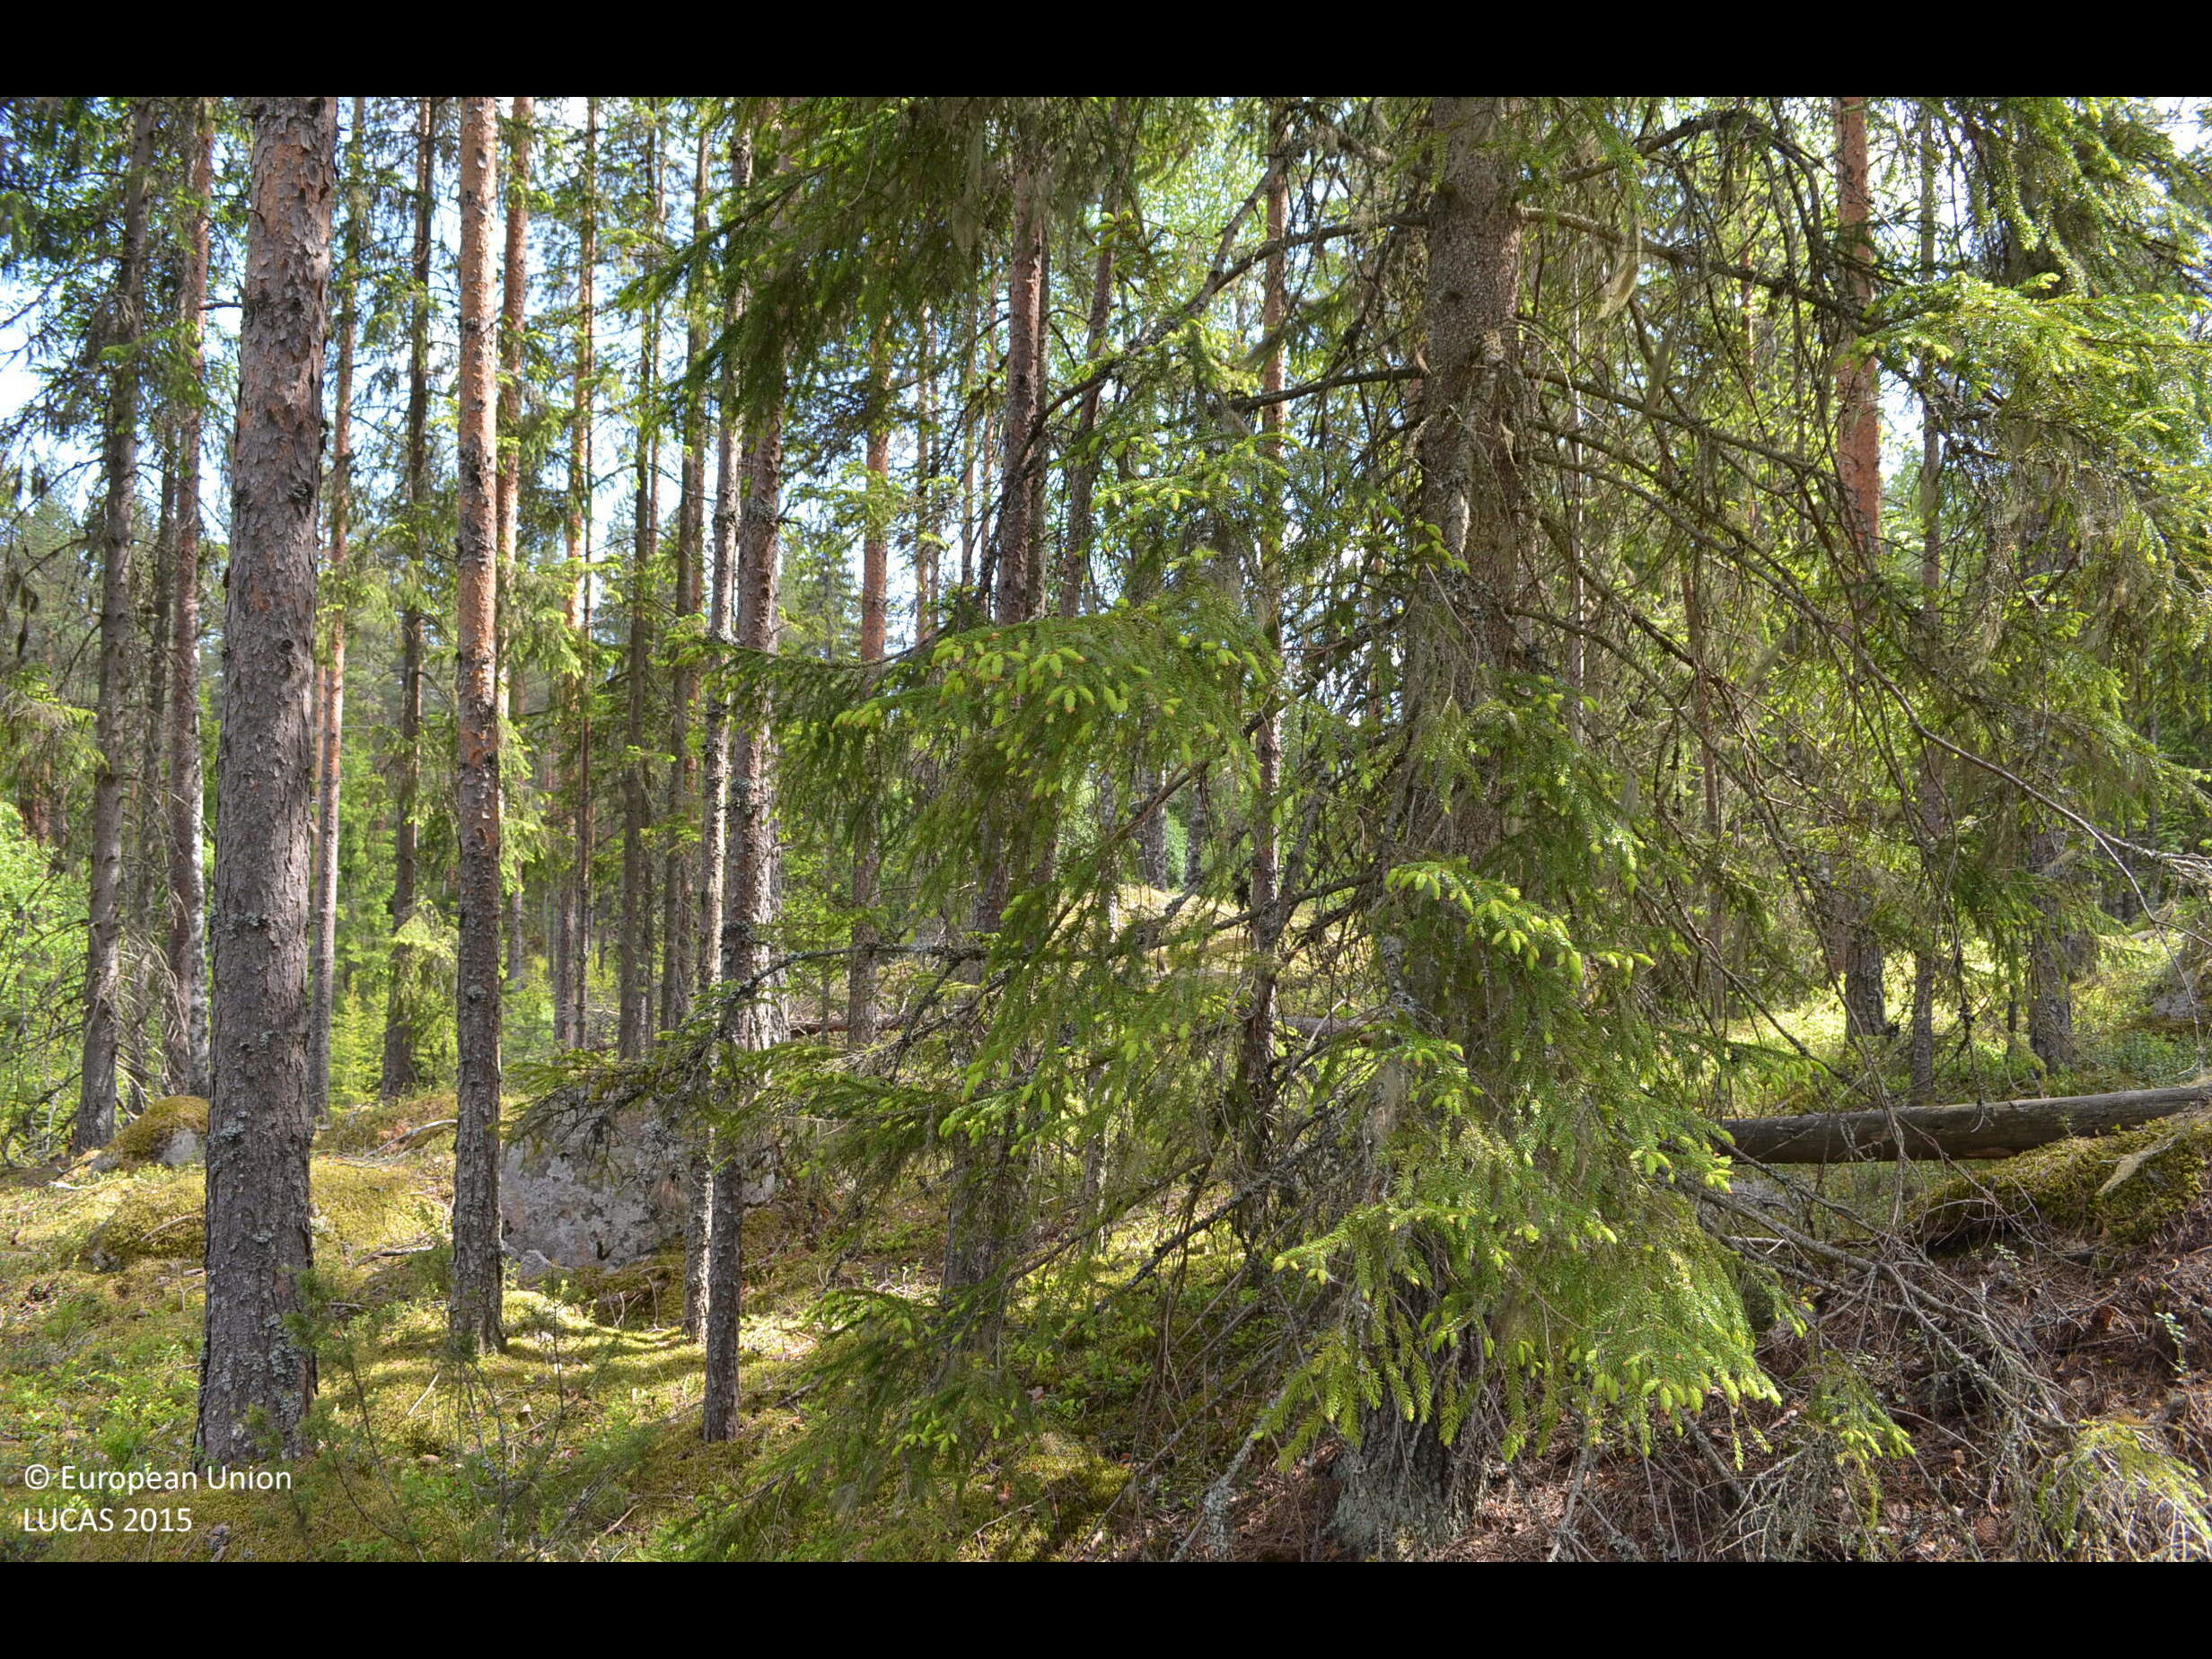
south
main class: Woodland
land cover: Other coniferous woodland
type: boreal forest
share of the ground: 50 - 75 %
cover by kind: coniferous forest trees 70 %, shrubs 25 %, lichens and mosses 5 %
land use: Forestry
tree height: > 5 m
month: June
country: FI
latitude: 61.8062
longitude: 23.2208
